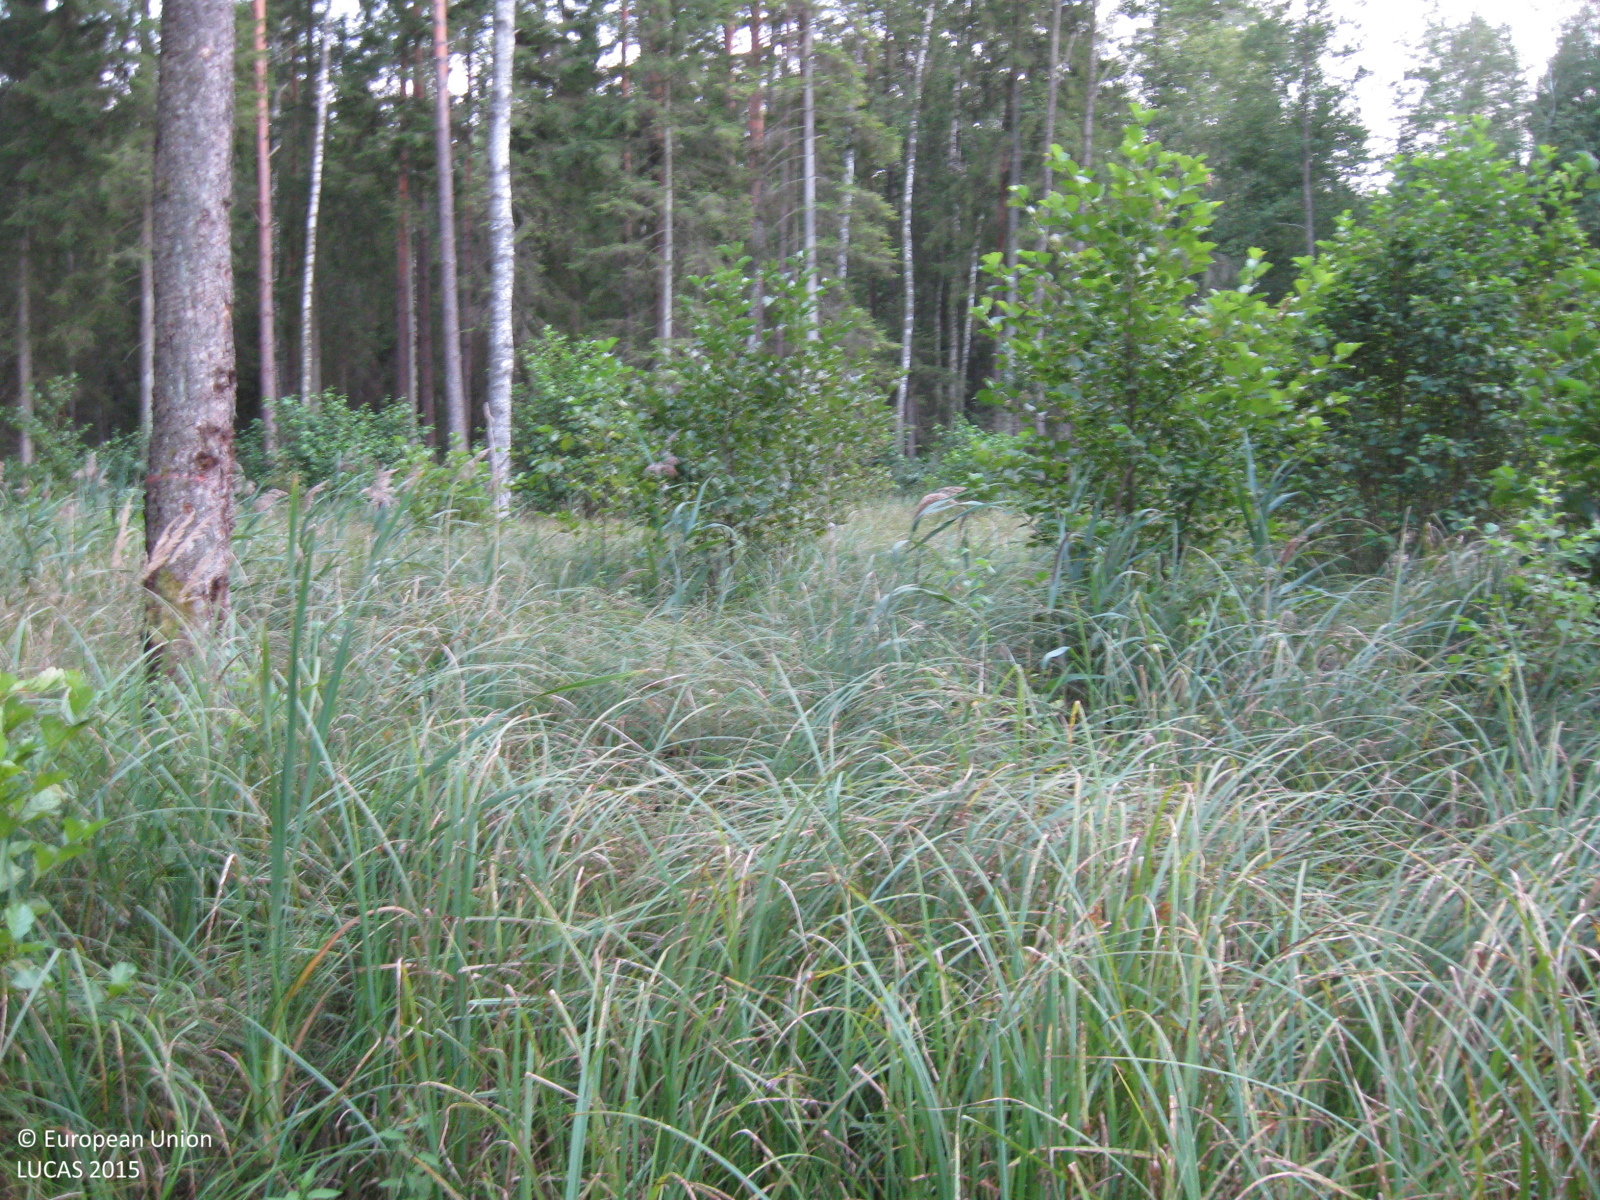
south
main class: Woodland
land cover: Broadleaved woodland
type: mire and swamp forests
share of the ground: 50 - 75 %
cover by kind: herbaceous plants 50 %, broadleaved forest trees 40 %, coniferous forest trees 10 %
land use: Forestry
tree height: < 5 m
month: August
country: LT
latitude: 55.3341
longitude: 22.8846
